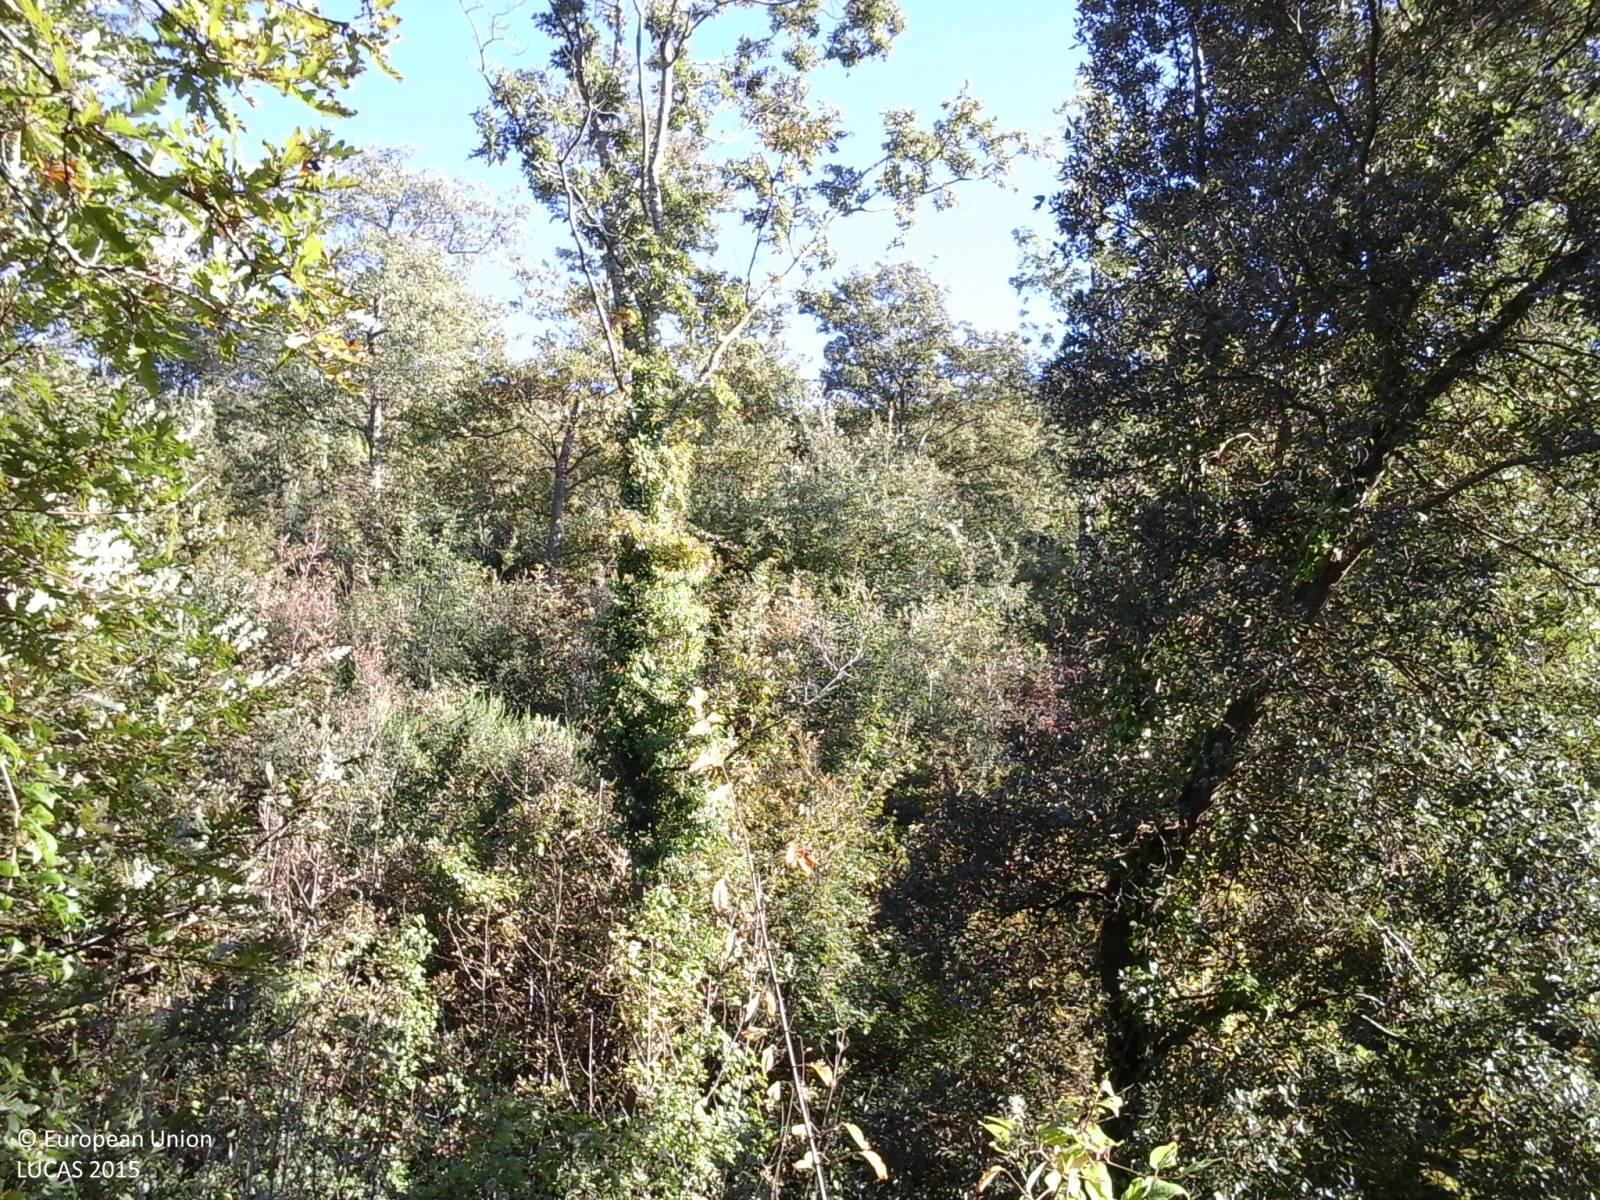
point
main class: Woodland
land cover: Broadleaved woodland
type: thermophilous deciduous forest
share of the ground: > 75 %
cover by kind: broadleaved forest trees 80 %, shrubs 20 %
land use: Forestry
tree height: > 5 m
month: October
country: IT
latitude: 43.3927
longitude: 10.5786
